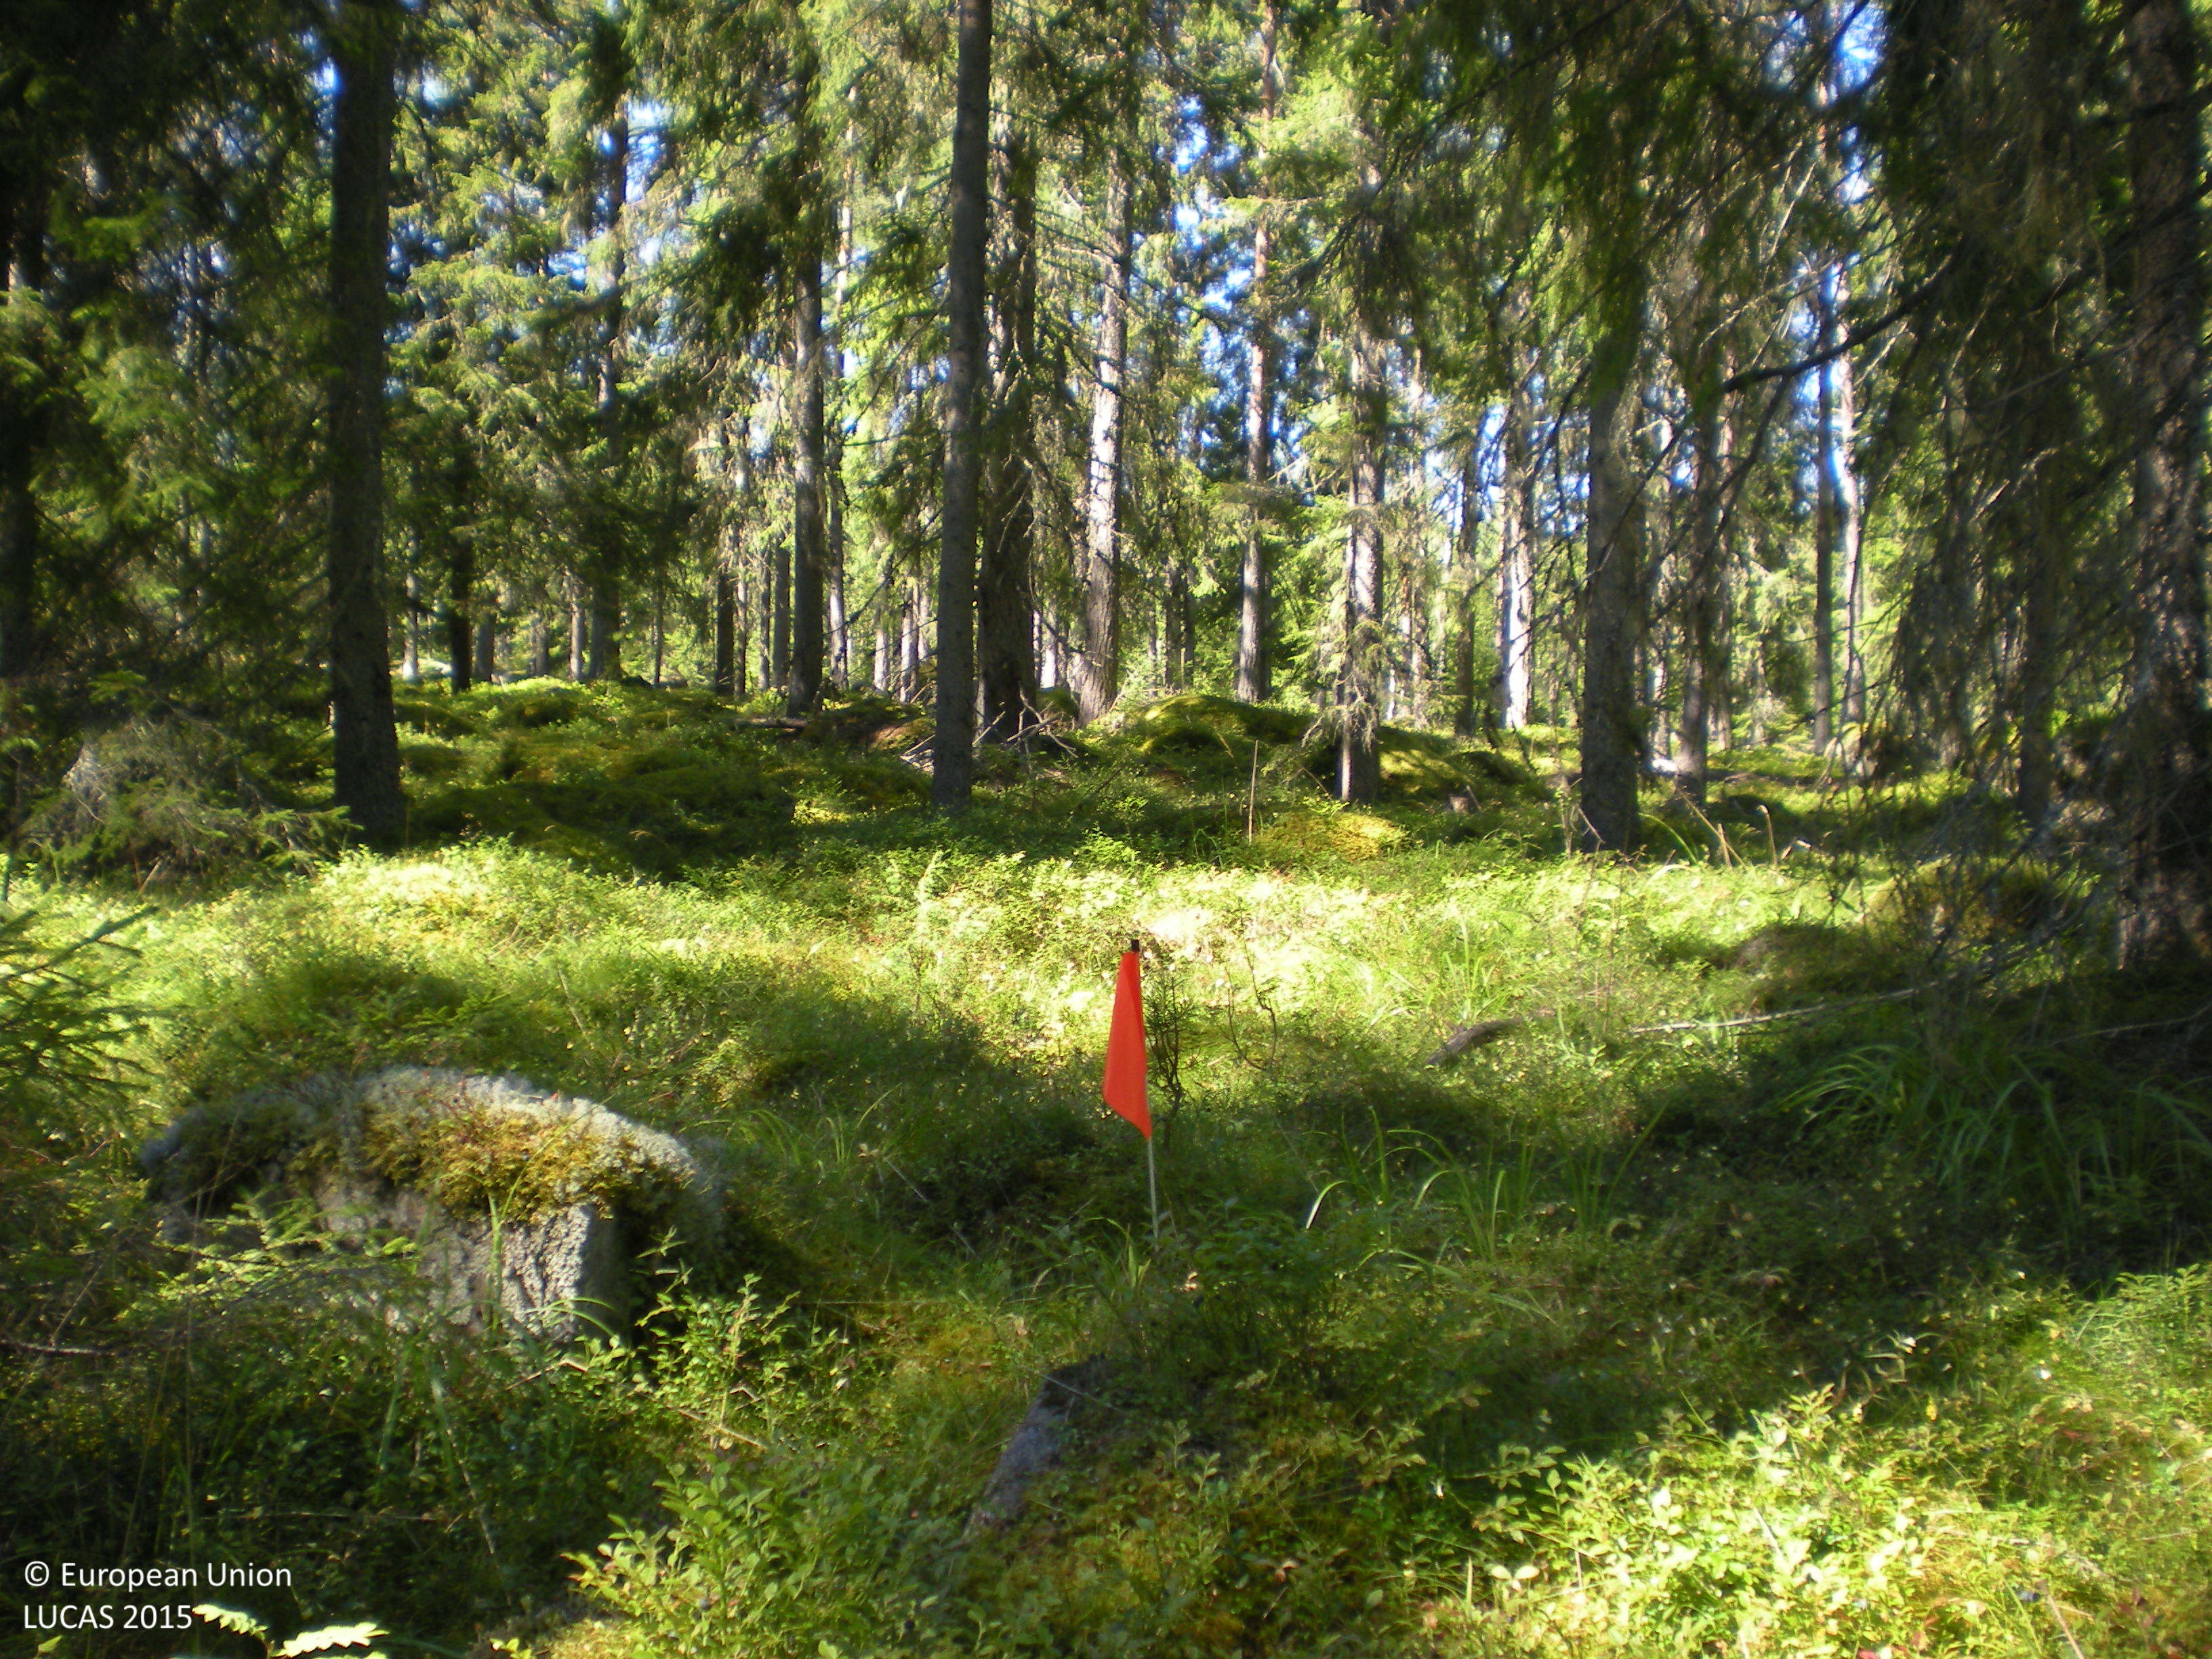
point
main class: Woodland
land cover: Spruce dominated coniferous woodland
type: boreal forest
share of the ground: 50 - 75 %
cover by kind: coniferous forest trees 65 %, shrubs 20 %, herbaceous plants 10 %, lichens and mosses 5 %
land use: Forestry
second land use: Amenities, museums, leisure
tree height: > 5 m
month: August
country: SE
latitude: 60.7064
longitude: 17.1161
